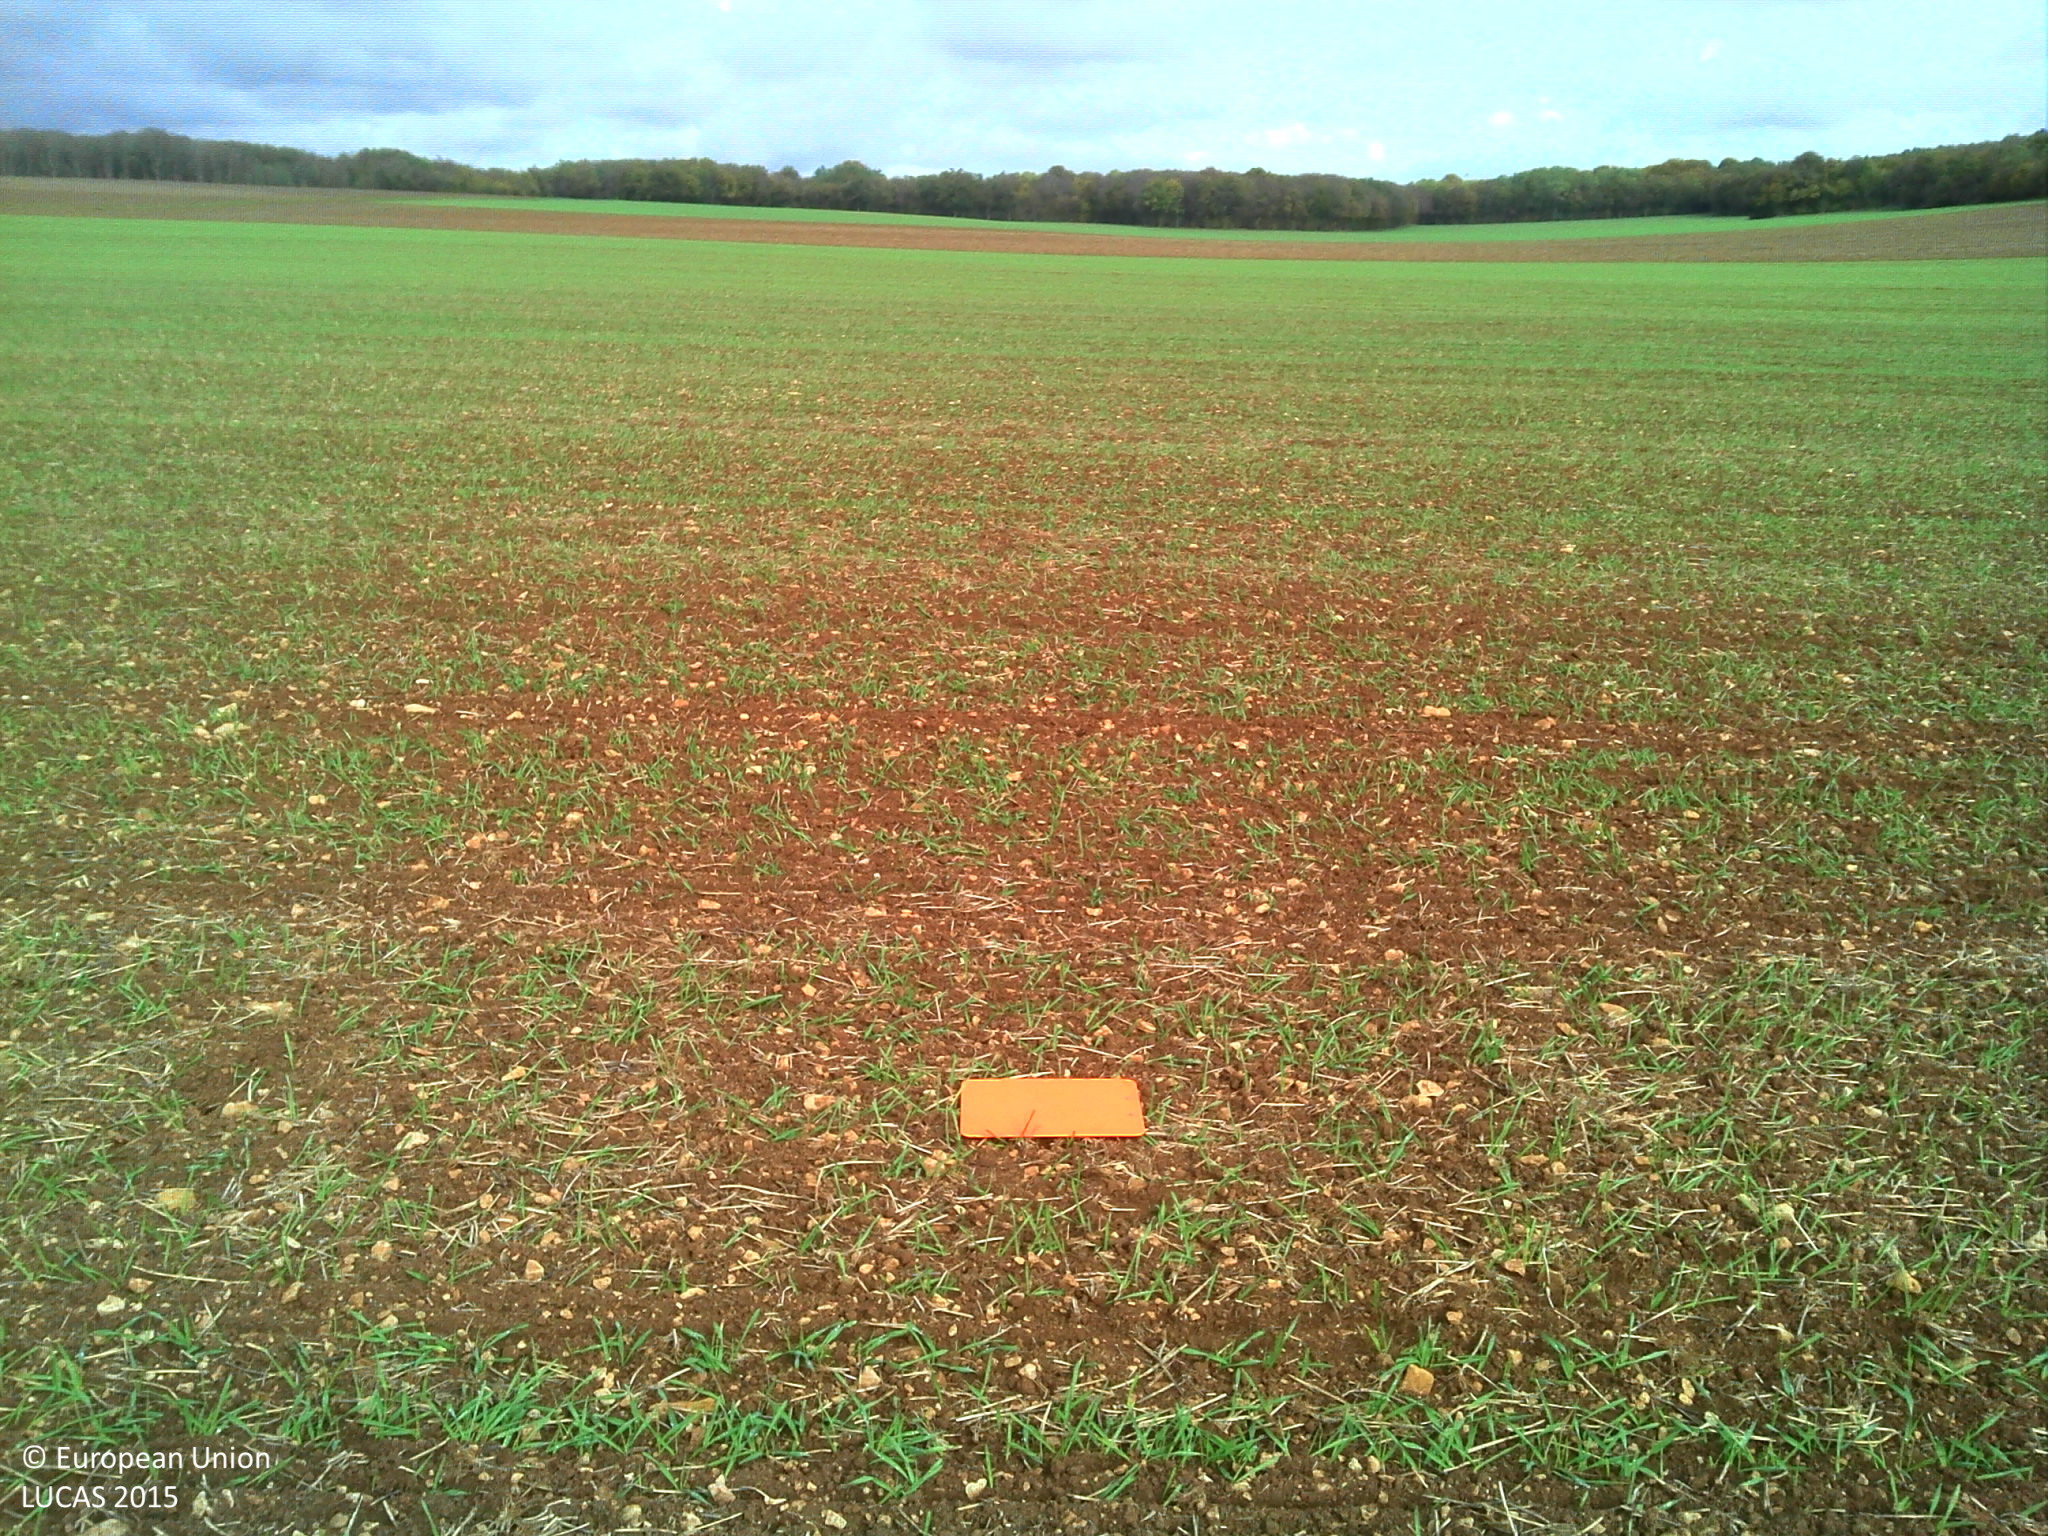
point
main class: Cropland
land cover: Common wheat
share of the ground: 25 - 50 %
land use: Agriculture (excluding fallow land and kitchen gardens)
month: October
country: FR
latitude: 47.3842
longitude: 4.9003
